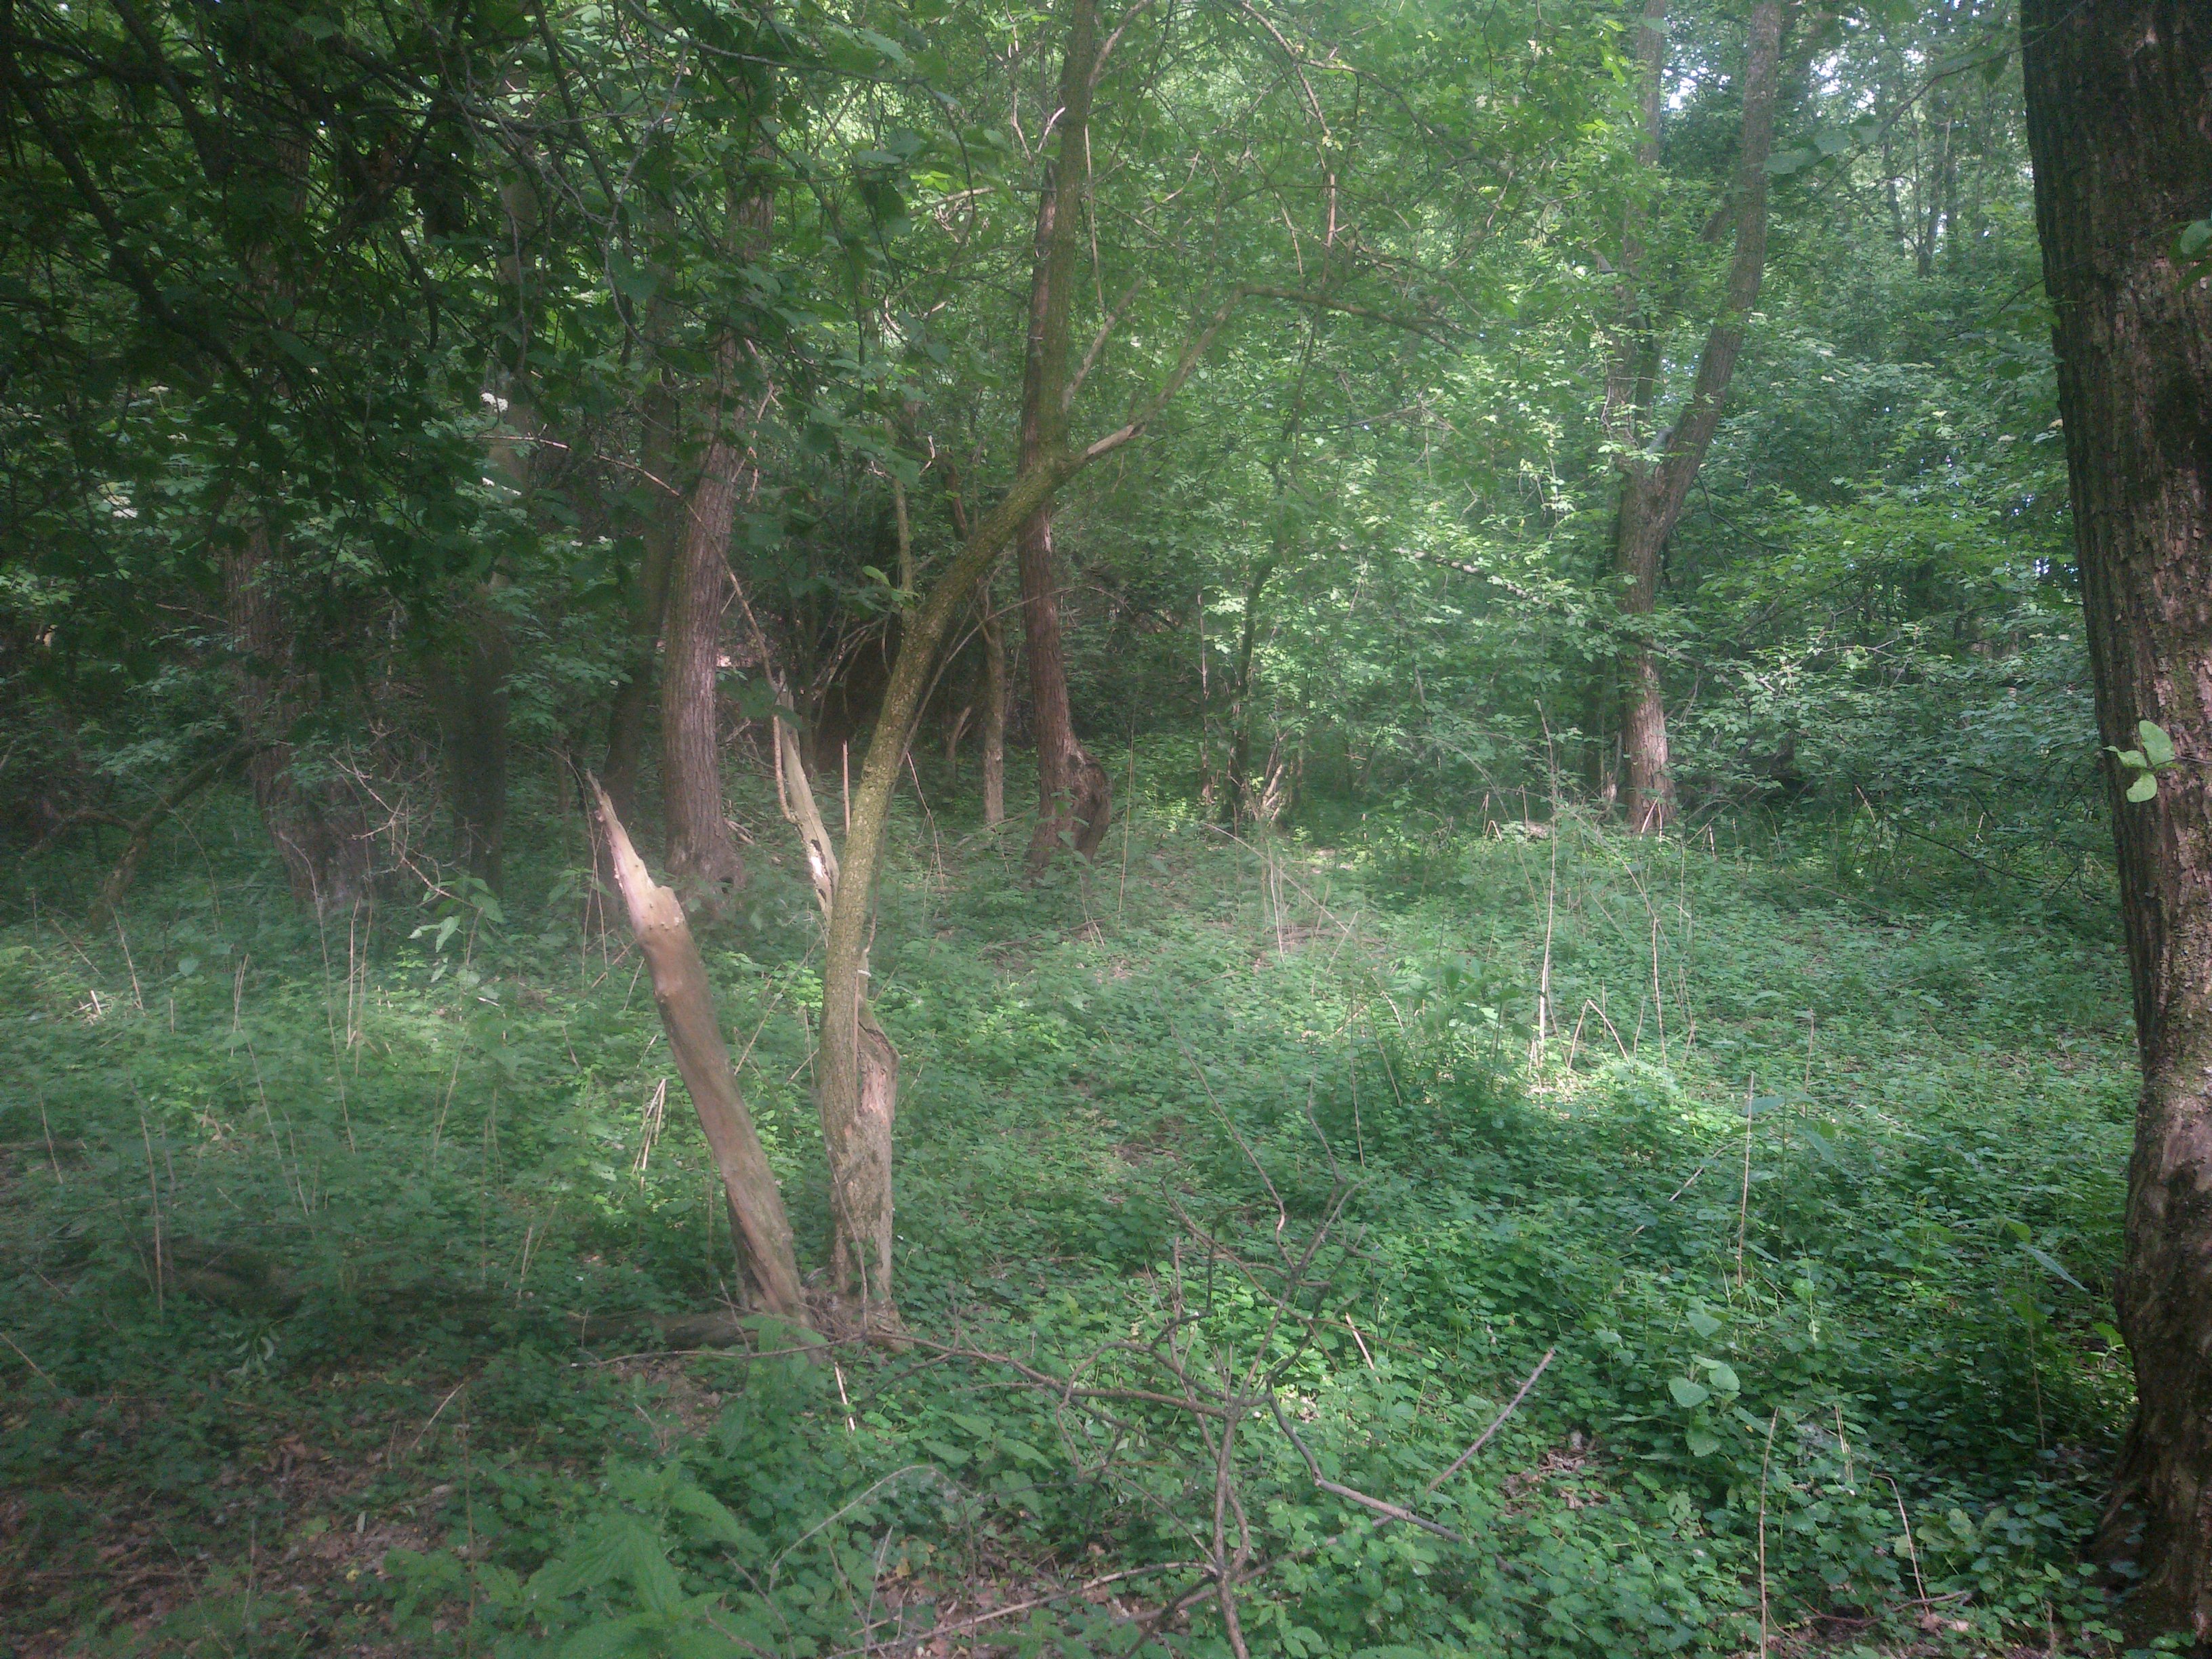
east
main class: Woodland
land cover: Broadleaved woodland
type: mesophytic deciduous forest
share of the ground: > 75 %
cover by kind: broadleaved forest trees 80 %, herbaceous plants 10 %, shrubs 5 %
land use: Forestry
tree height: > 5 m
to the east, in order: Broadleaved woodland; Maize
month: May
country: PL
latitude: 50.3091
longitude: 17.6097
